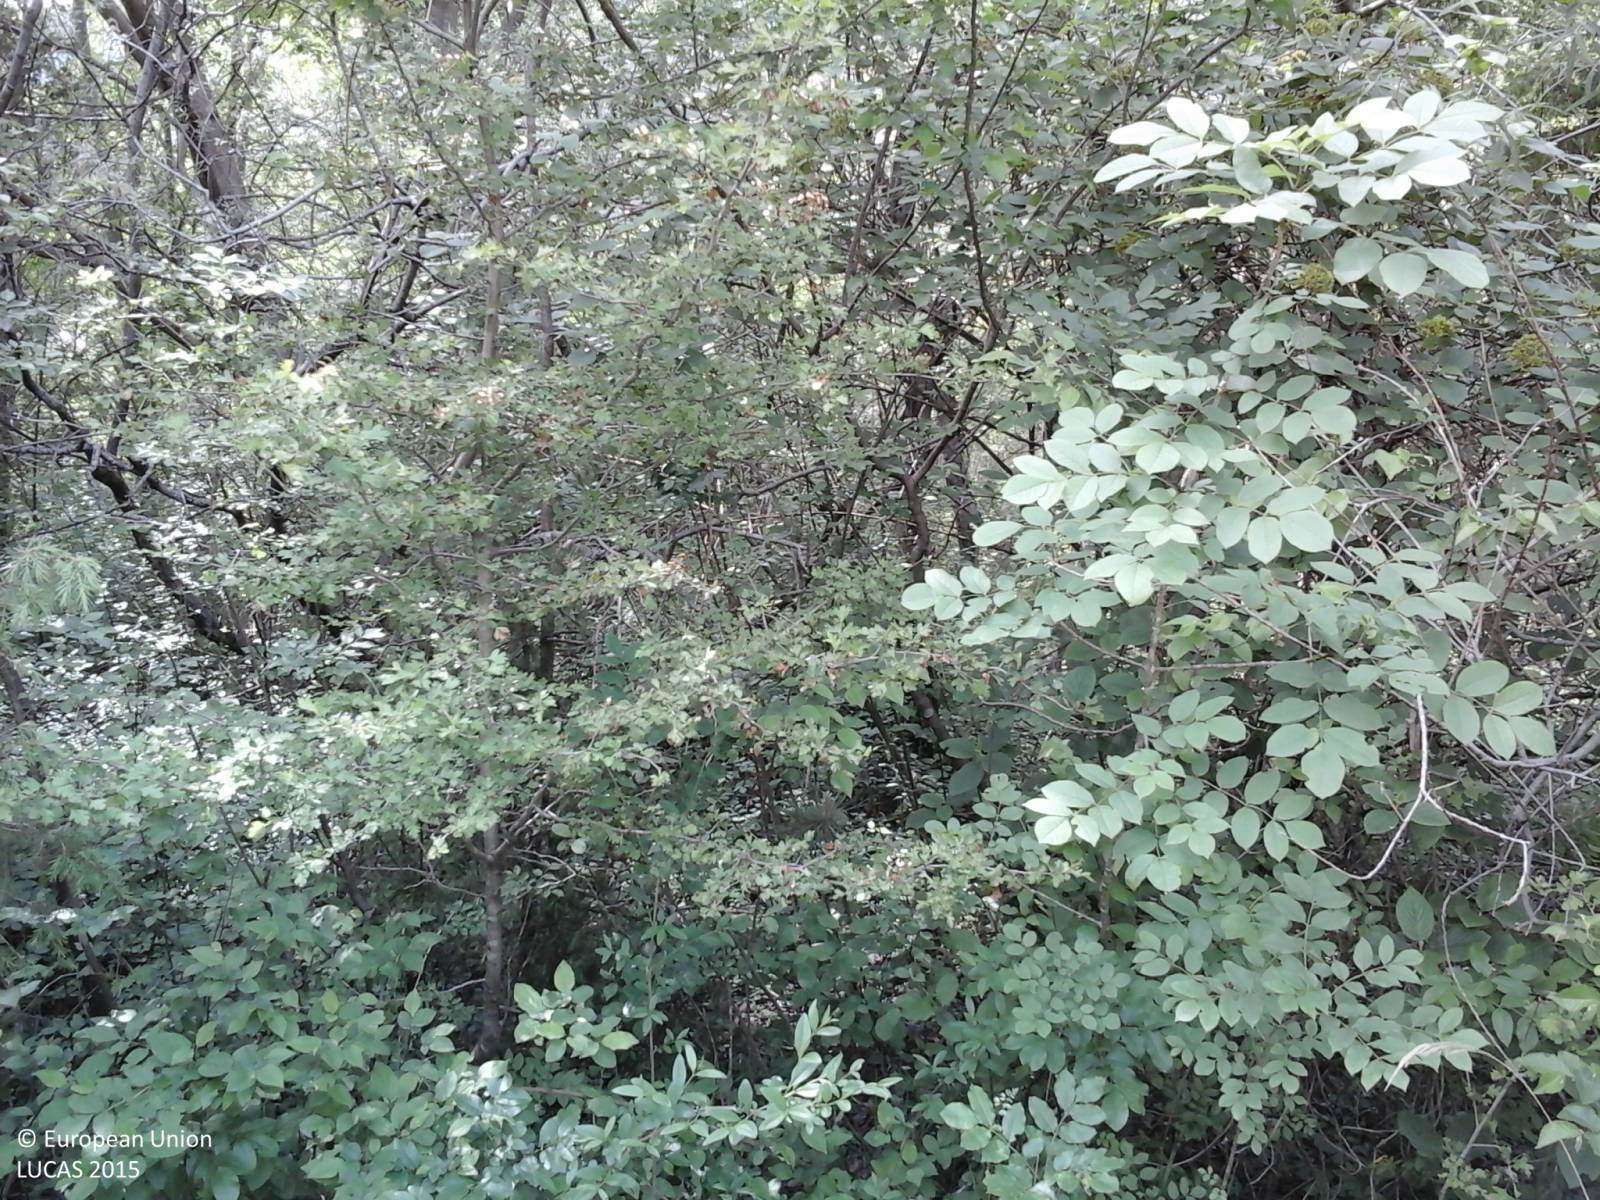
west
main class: Woodland
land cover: Broadleaved woodland
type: floodplain forest
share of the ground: > 75 %
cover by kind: broadleaved forest trees 50 %, shrubs 35 %, coniferous forest trees 10 %, herbaceous plants 5 %
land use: Forestry
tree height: > 5 m
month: May
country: IT
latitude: 46.2358
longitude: 13.0441
